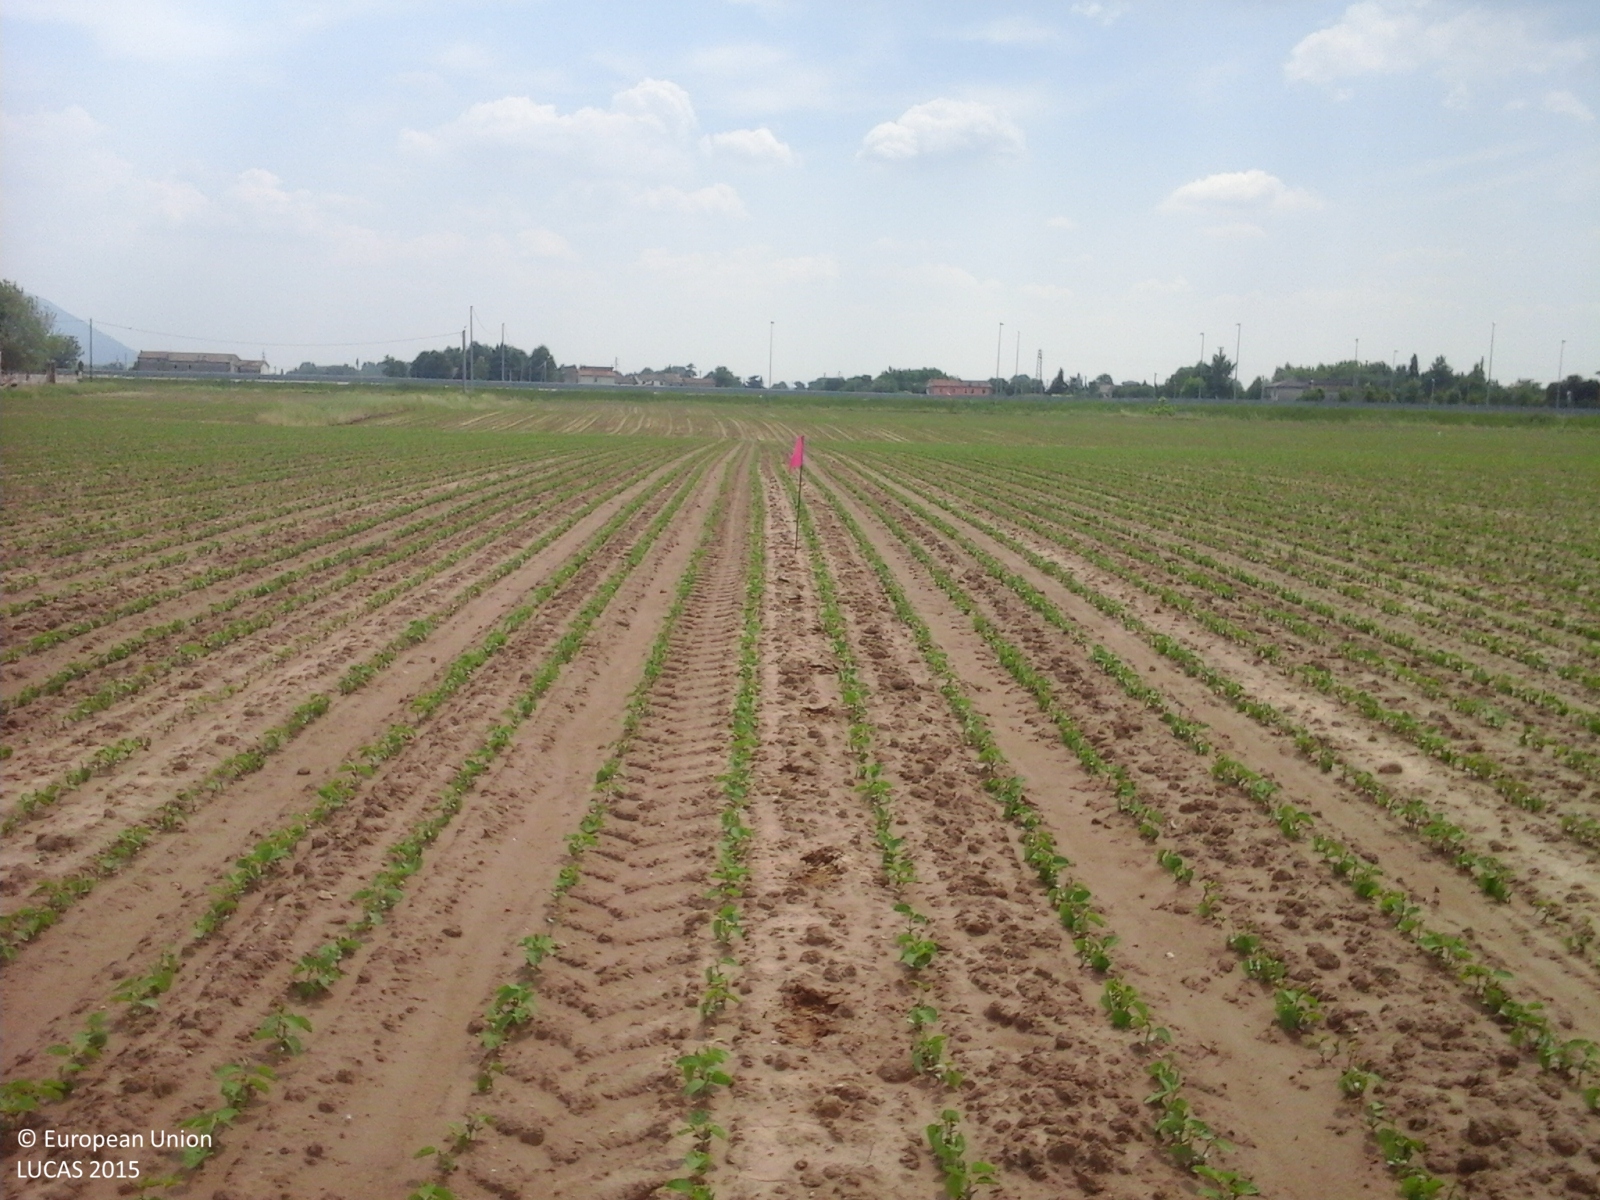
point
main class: Cropland
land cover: Soya
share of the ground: < 10 %
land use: Agriculture (excluding fallow land and kitchen gardens)
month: May
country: IT
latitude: 45.4559
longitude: 11.6213
